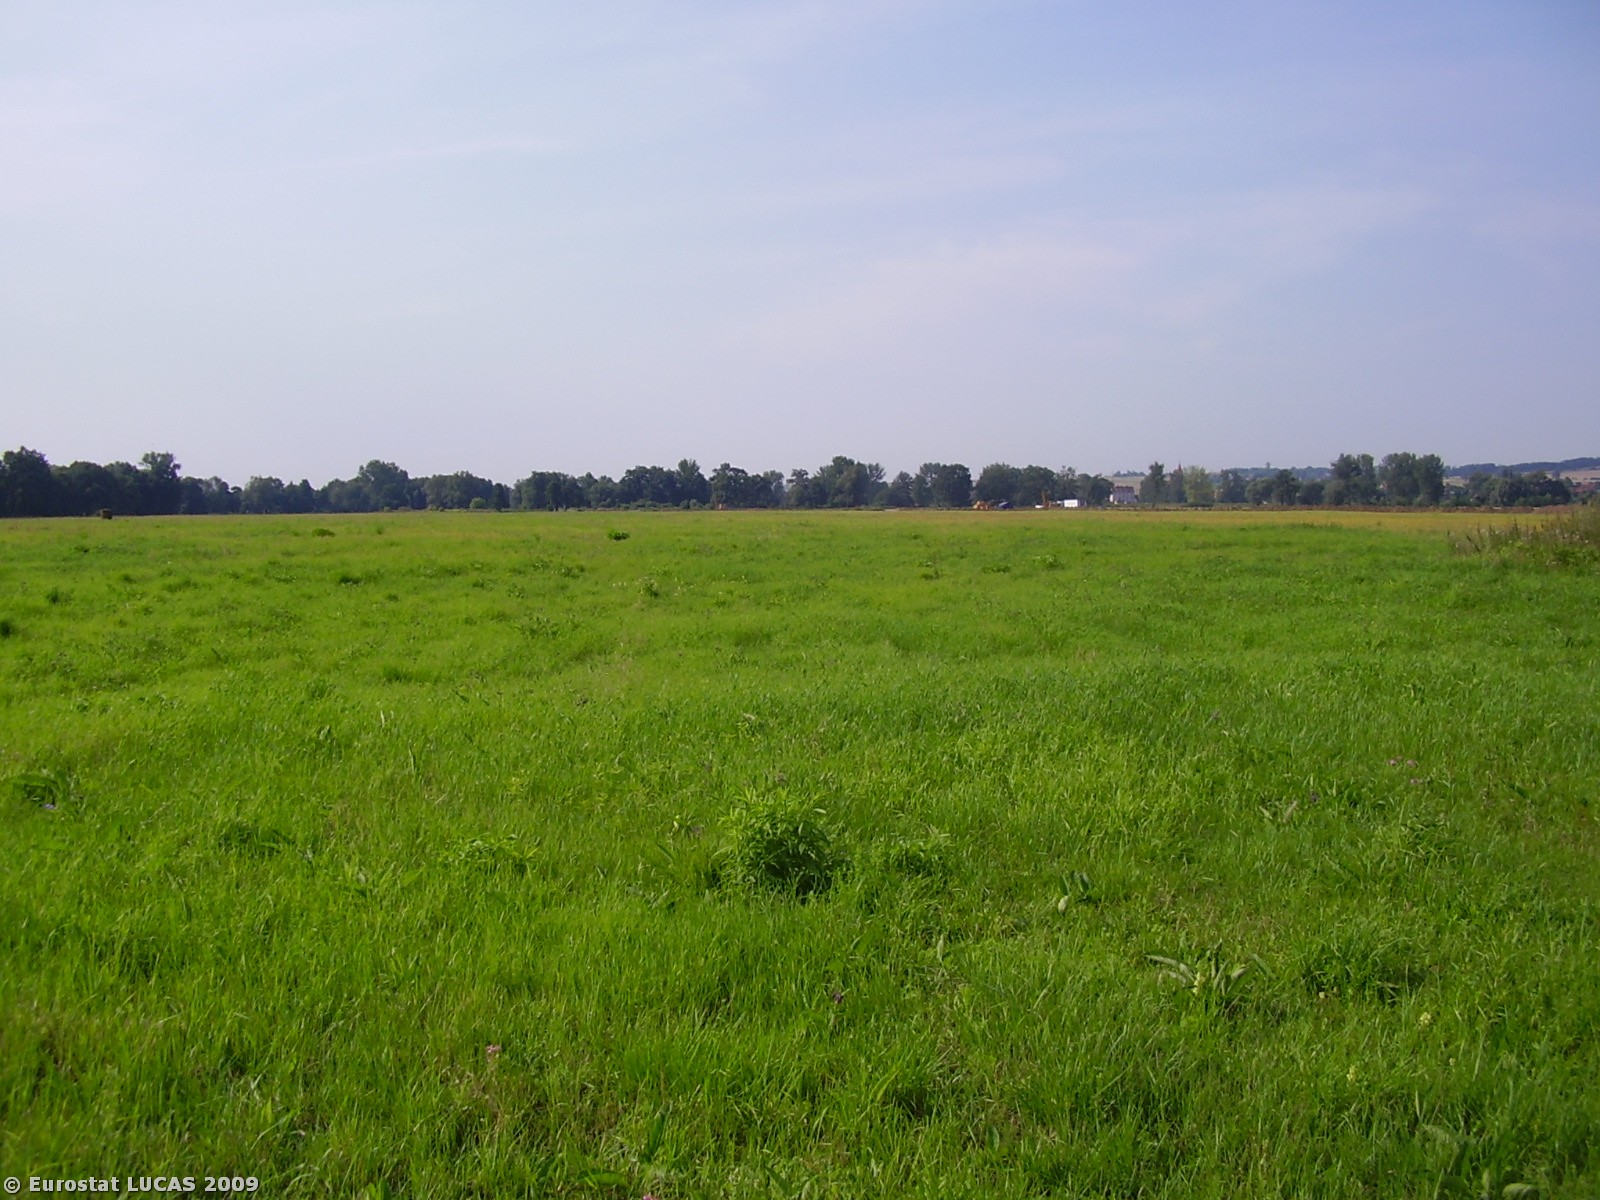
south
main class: Grassland
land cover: Grassland without tree/shrub cover
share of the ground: > 75 %
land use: Agriculture (excluding fallow land and kitchen gardens)
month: August
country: PL
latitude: 51.6591
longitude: 16.1502
